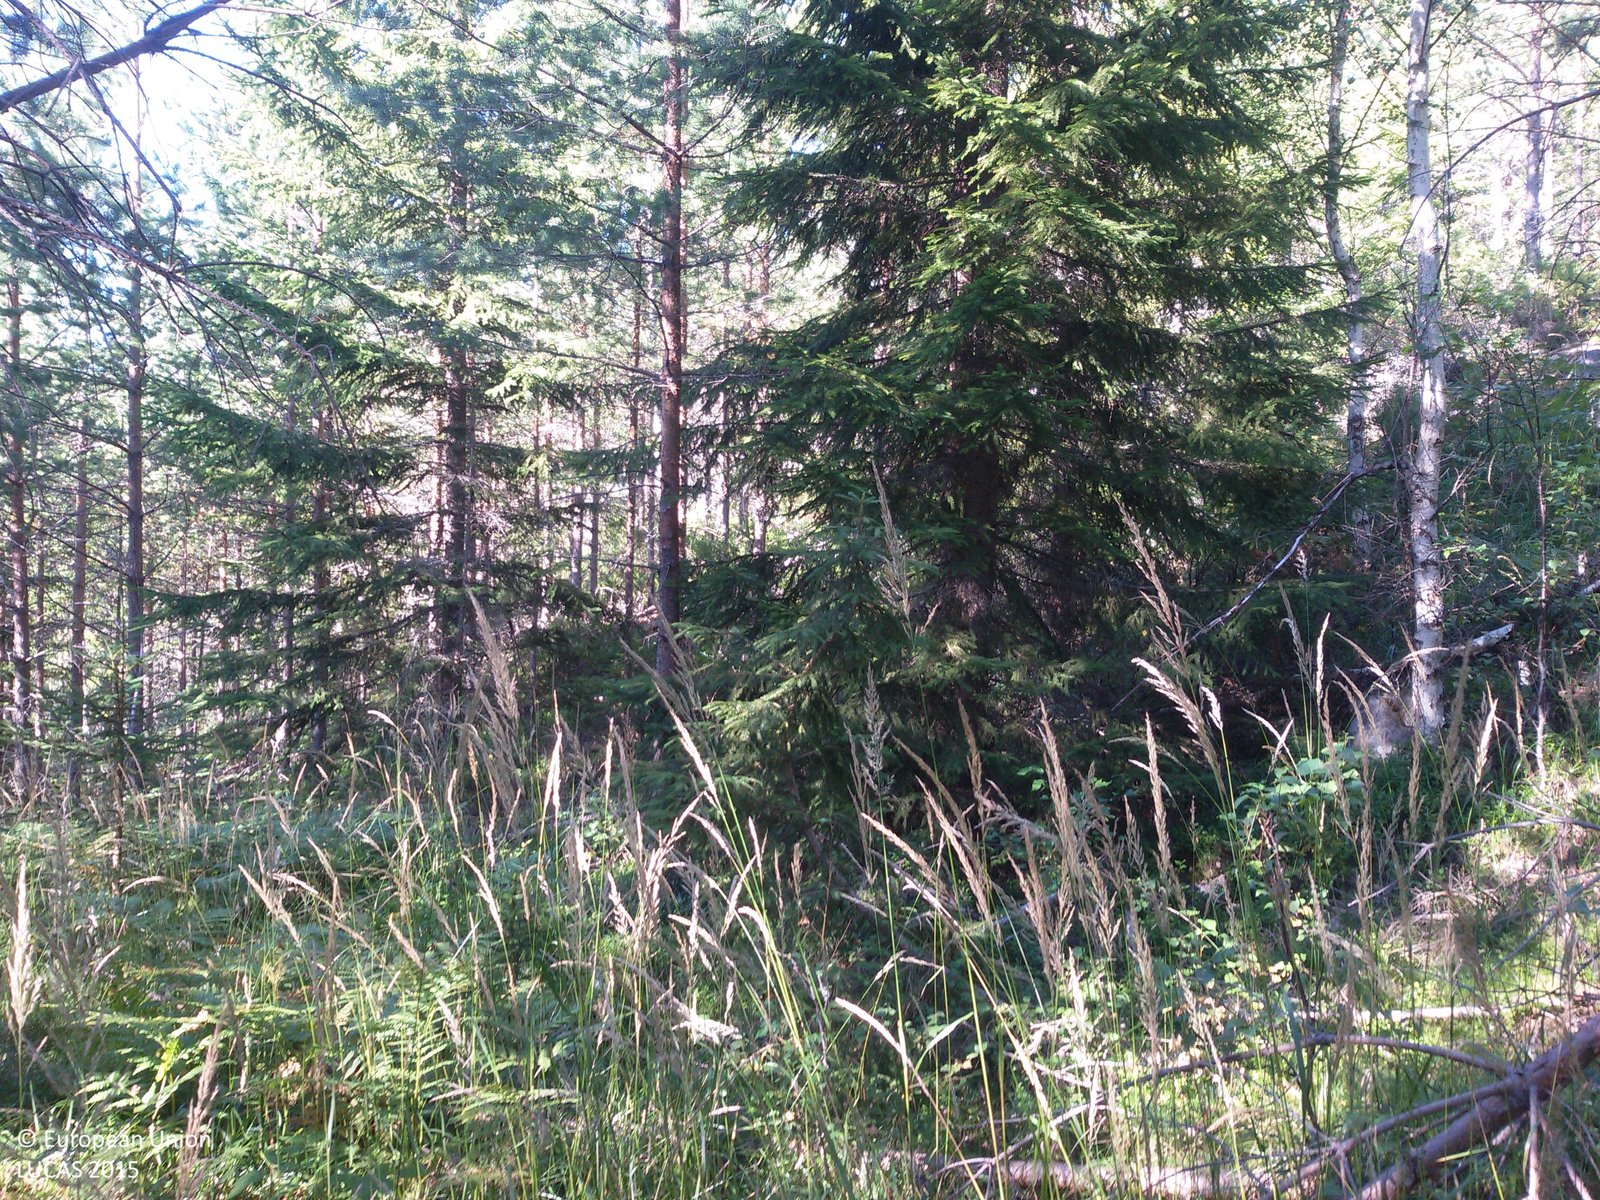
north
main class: Woodland
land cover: Pine dominated coniferous woodland
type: boreal forest
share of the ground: > 75 %
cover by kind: coniferous forest trees 80 %, shrubs 10 %, herbaceous plants 10 %
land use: Forestry
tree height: > 5 m
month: August
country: SE
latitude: 60.6534
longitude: 15.8956
